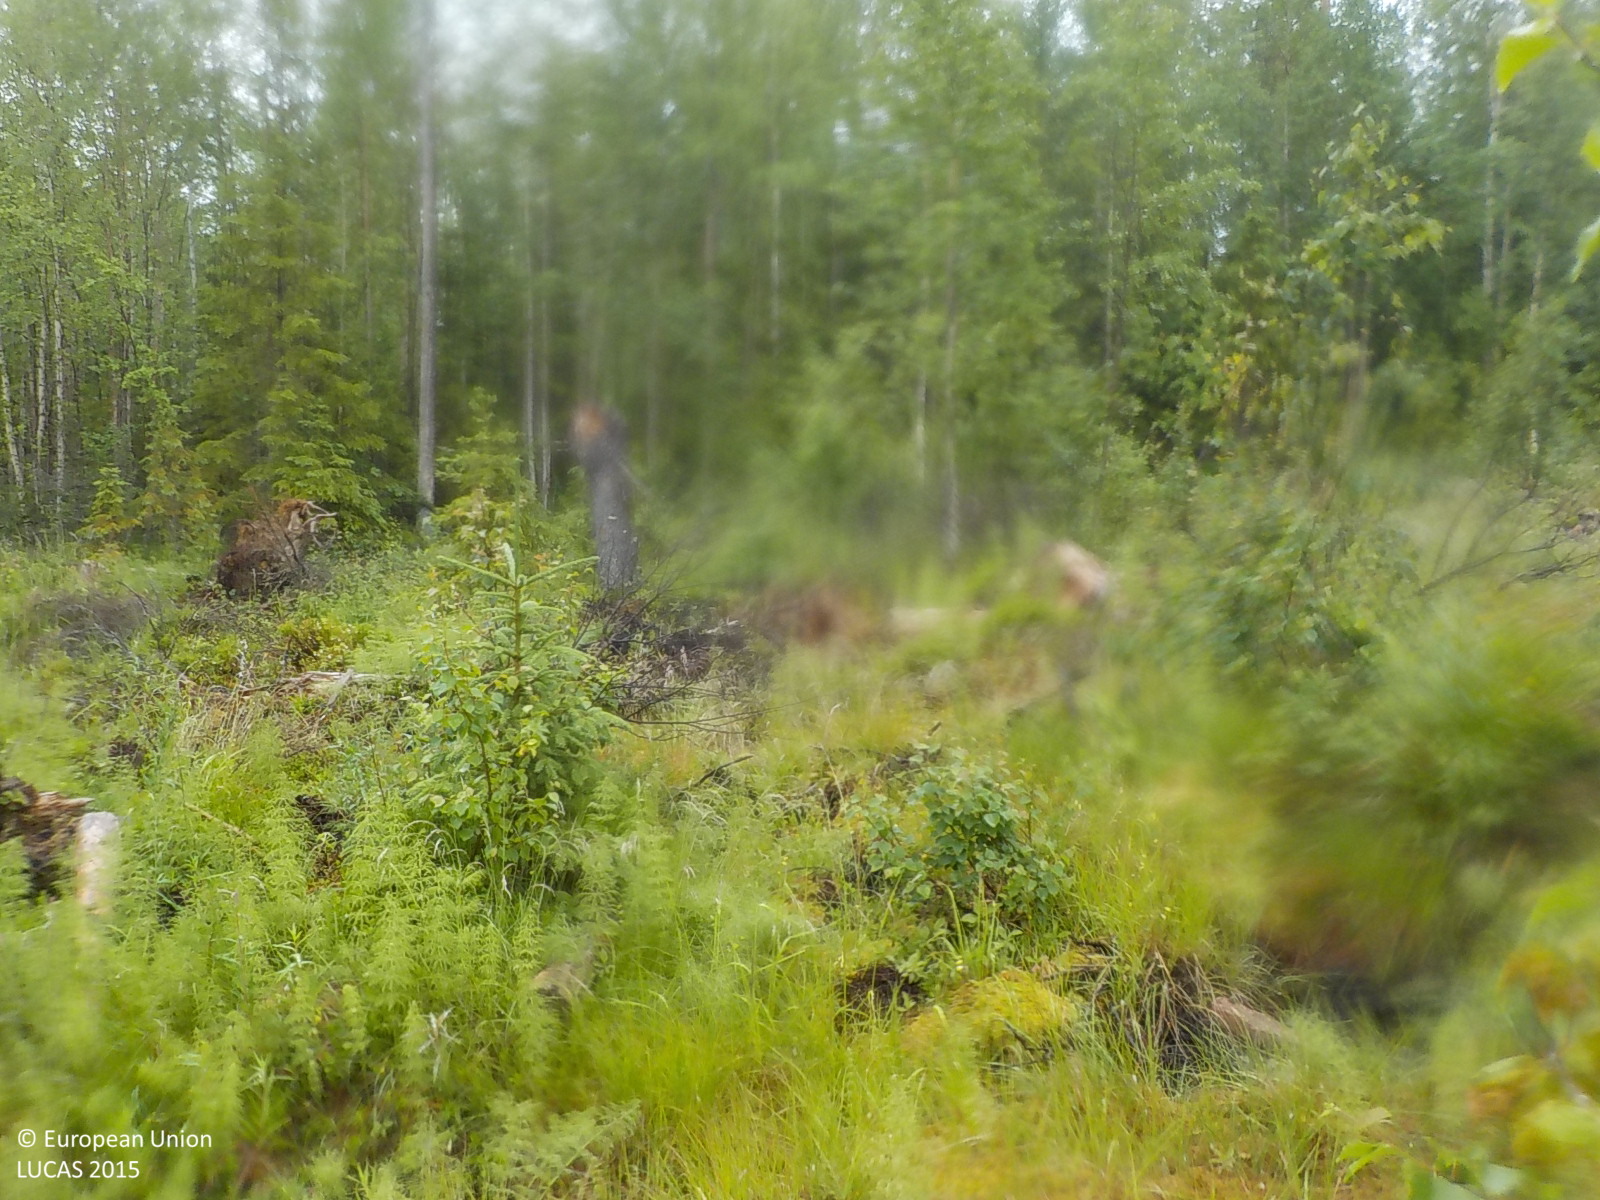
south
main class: Woodland
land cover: Other mixed woodland
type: boreal forest
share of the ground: > 75 %
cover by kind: coniferous forest trees 40 %, broadleaved forest trees 40 %, herbaceous plants 15 %, shrubs 5 %
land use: Forestry
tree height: < 5 m
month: July
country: SE
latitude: 63.0528
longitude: 16.8793
